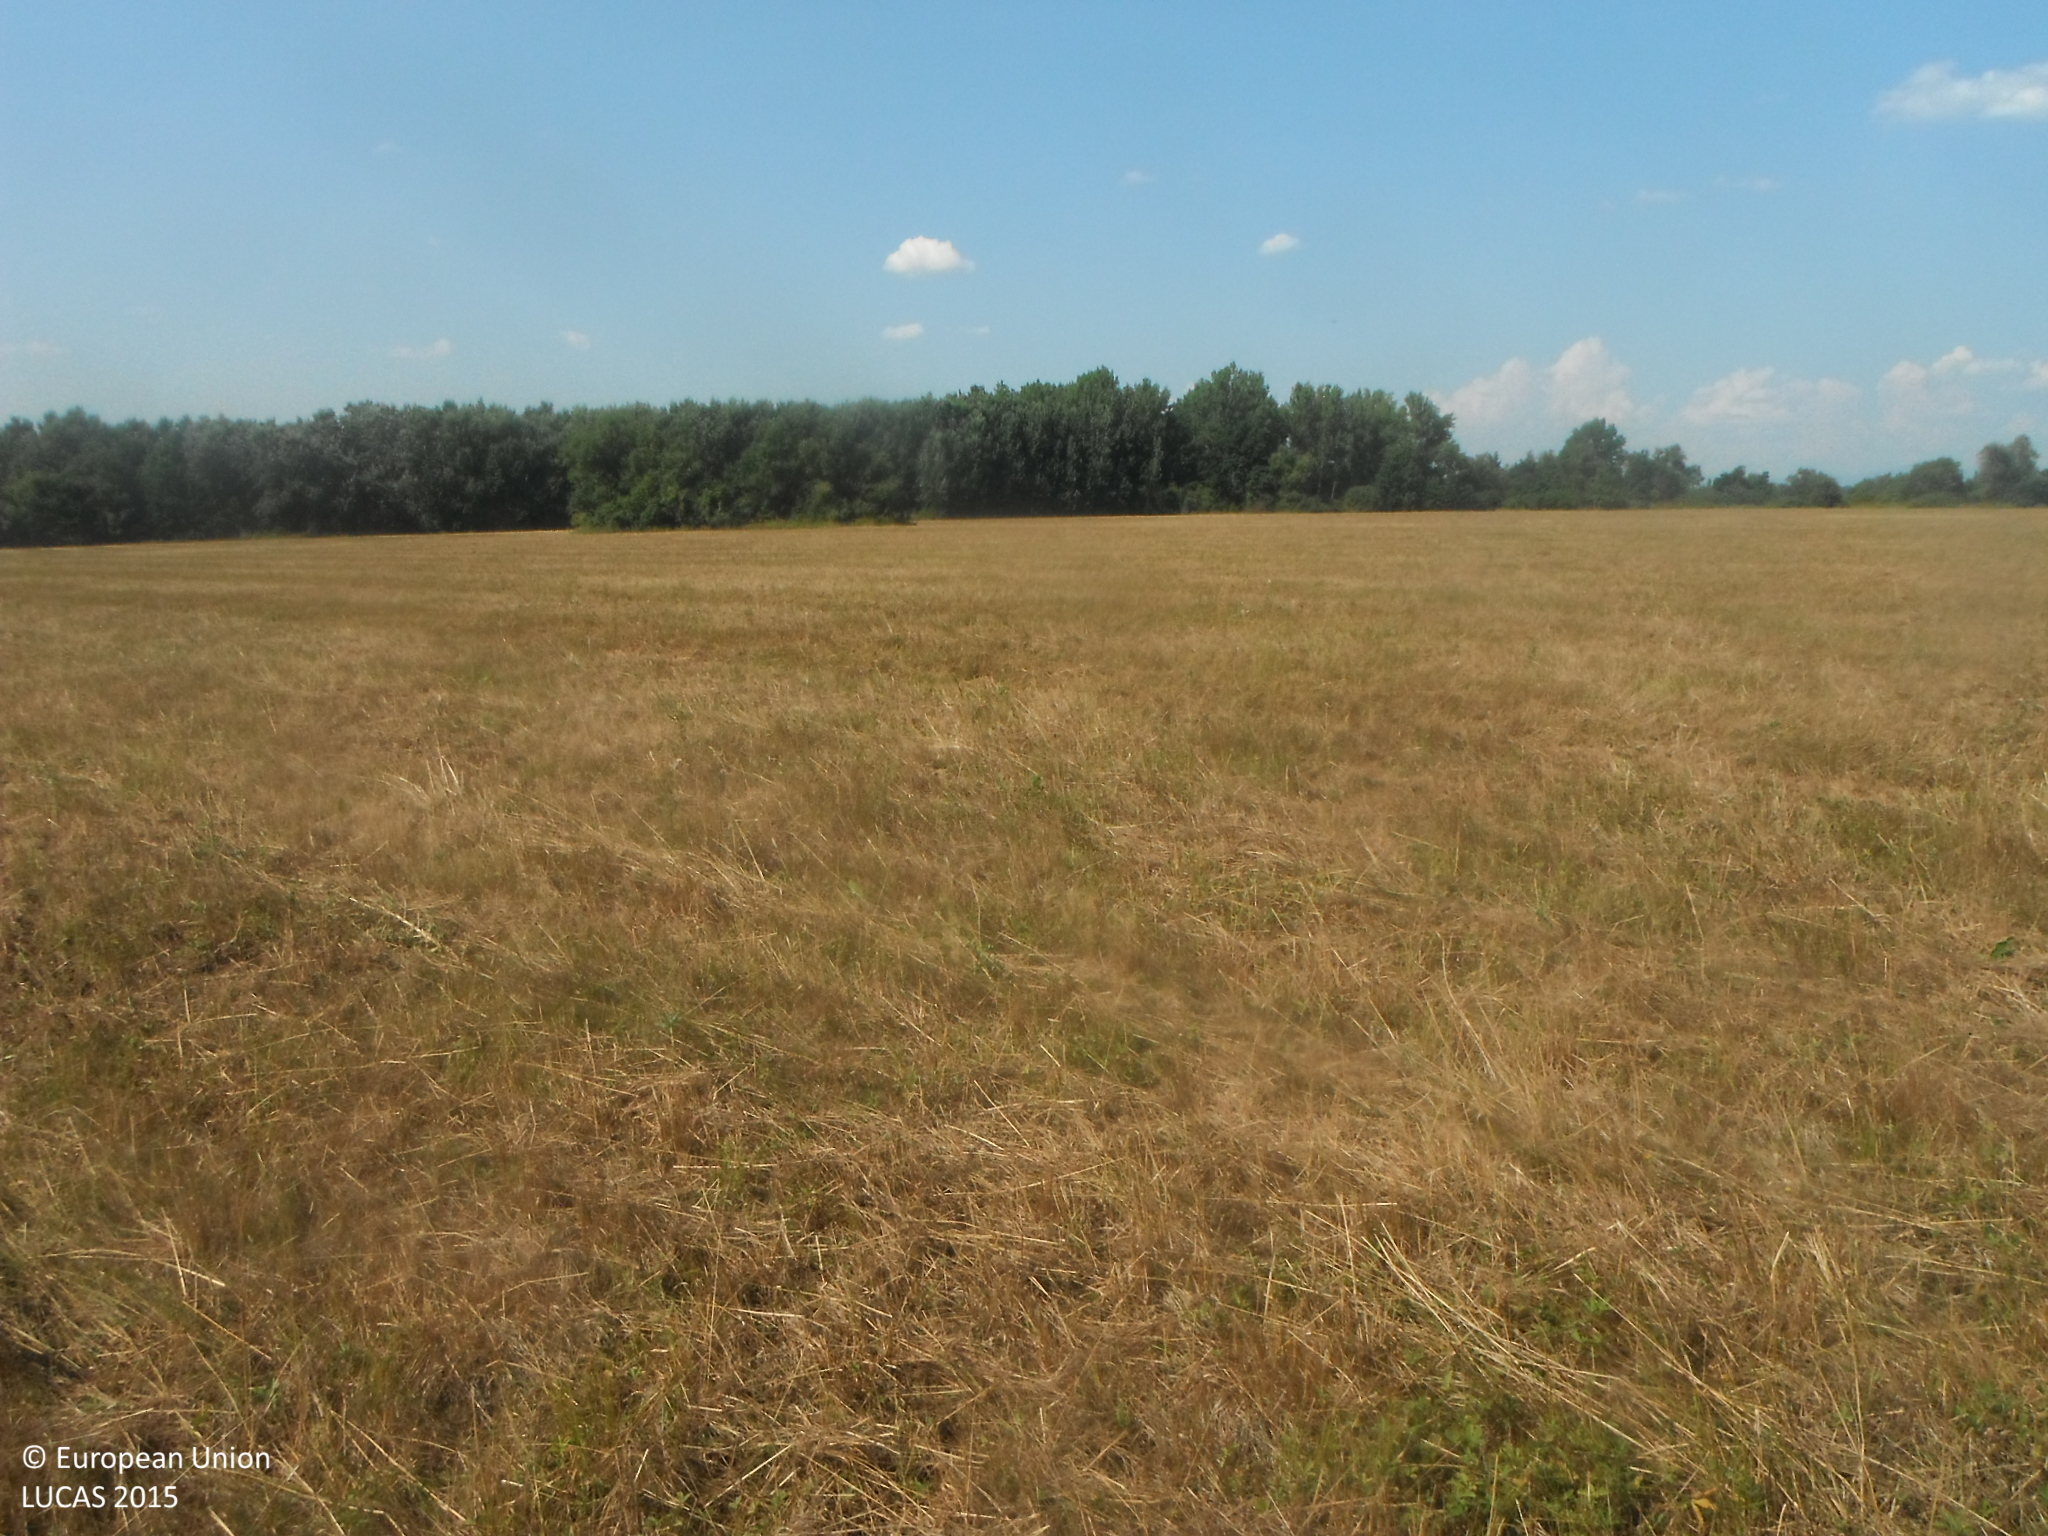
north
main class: Grassland
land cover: Grassland without tree/shrub cover
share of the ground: > 75 %
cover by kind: herbaceous plants 100 %
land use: Agriculture (excluding fallow land and kitchen gardens)
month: August
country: SK
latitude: 48.5484
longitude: 21.8237
